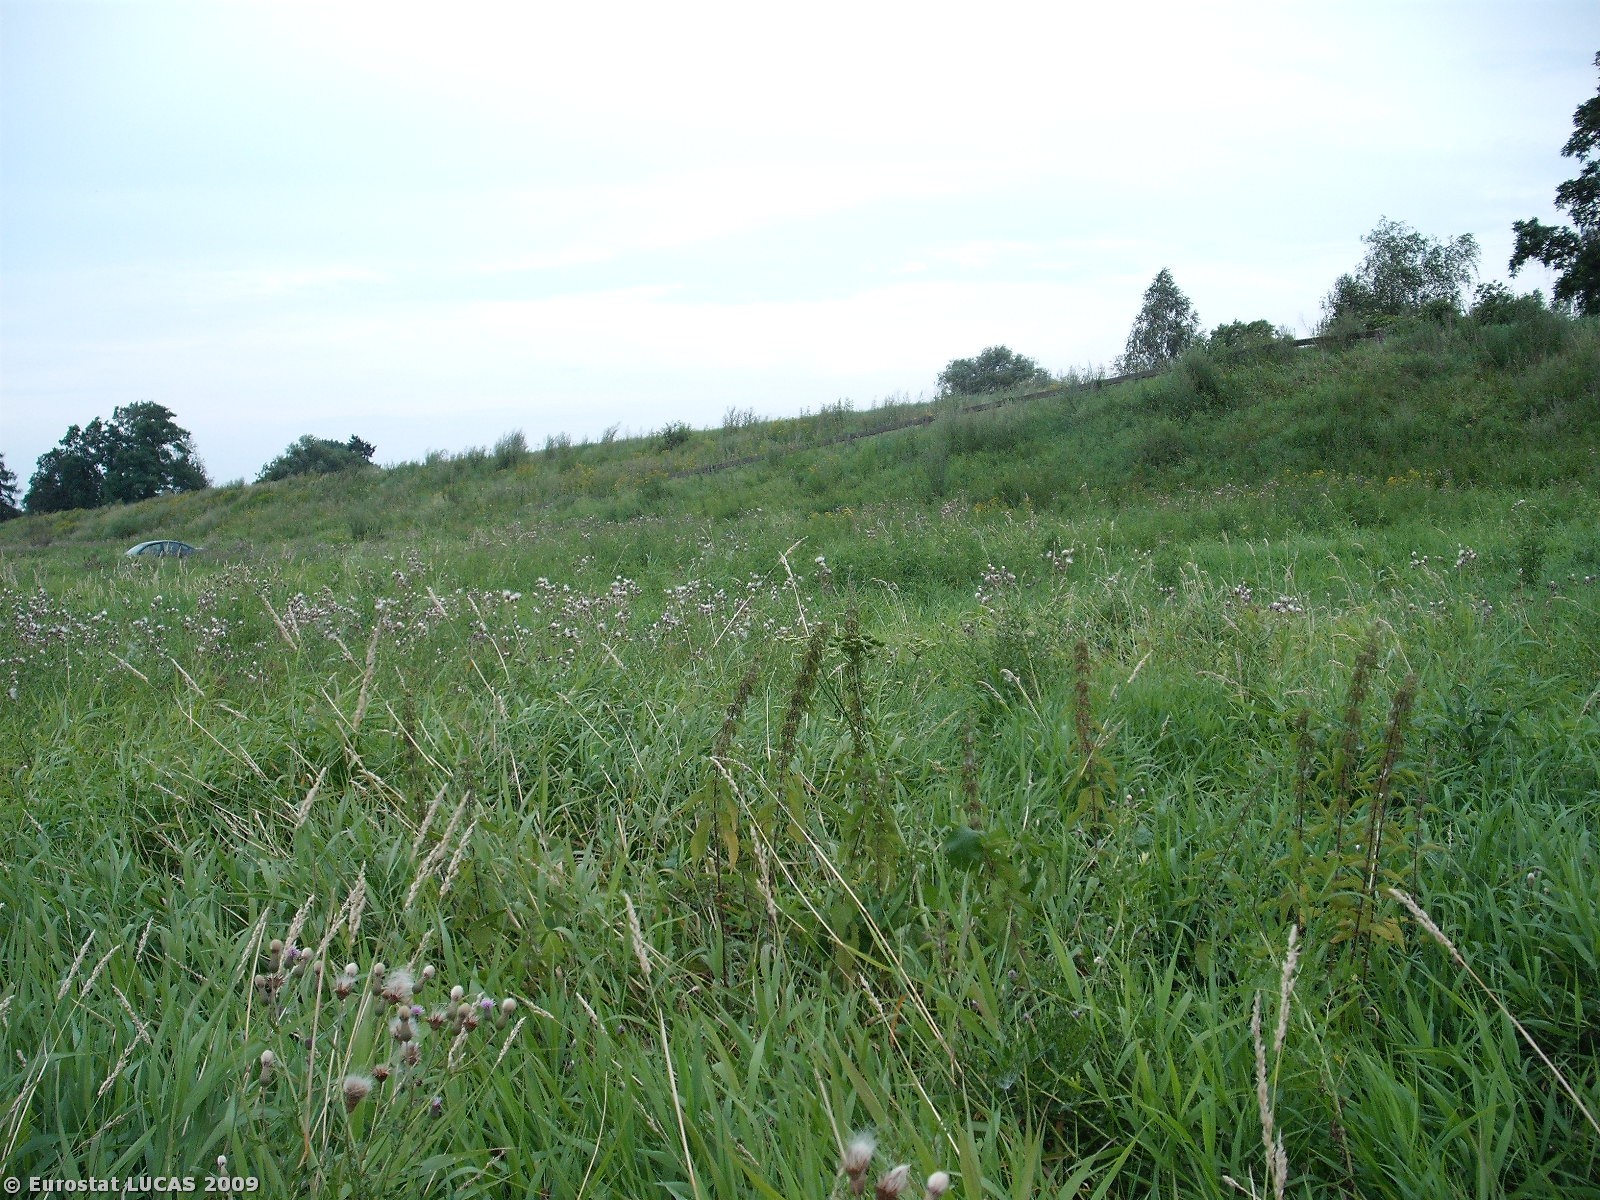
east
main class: Grassland
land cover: Grassland without tree/shrub cover
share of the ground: > 75 %
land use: Unused
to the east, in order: Grassland without tree/shrub cover; Other structural elements; Paved roads, cycling and walking lanes; Grassland without tree/shrub cover; Grassland with sparse tree/shrub cover; Grass margins; Paved roads, cycling and walking lanes; Grass margins; Electric lines; Grassland without tree/shrub cover; Artificial constructions in urban areas
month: July
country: PL
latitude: 50.0505
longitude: 20.2155
